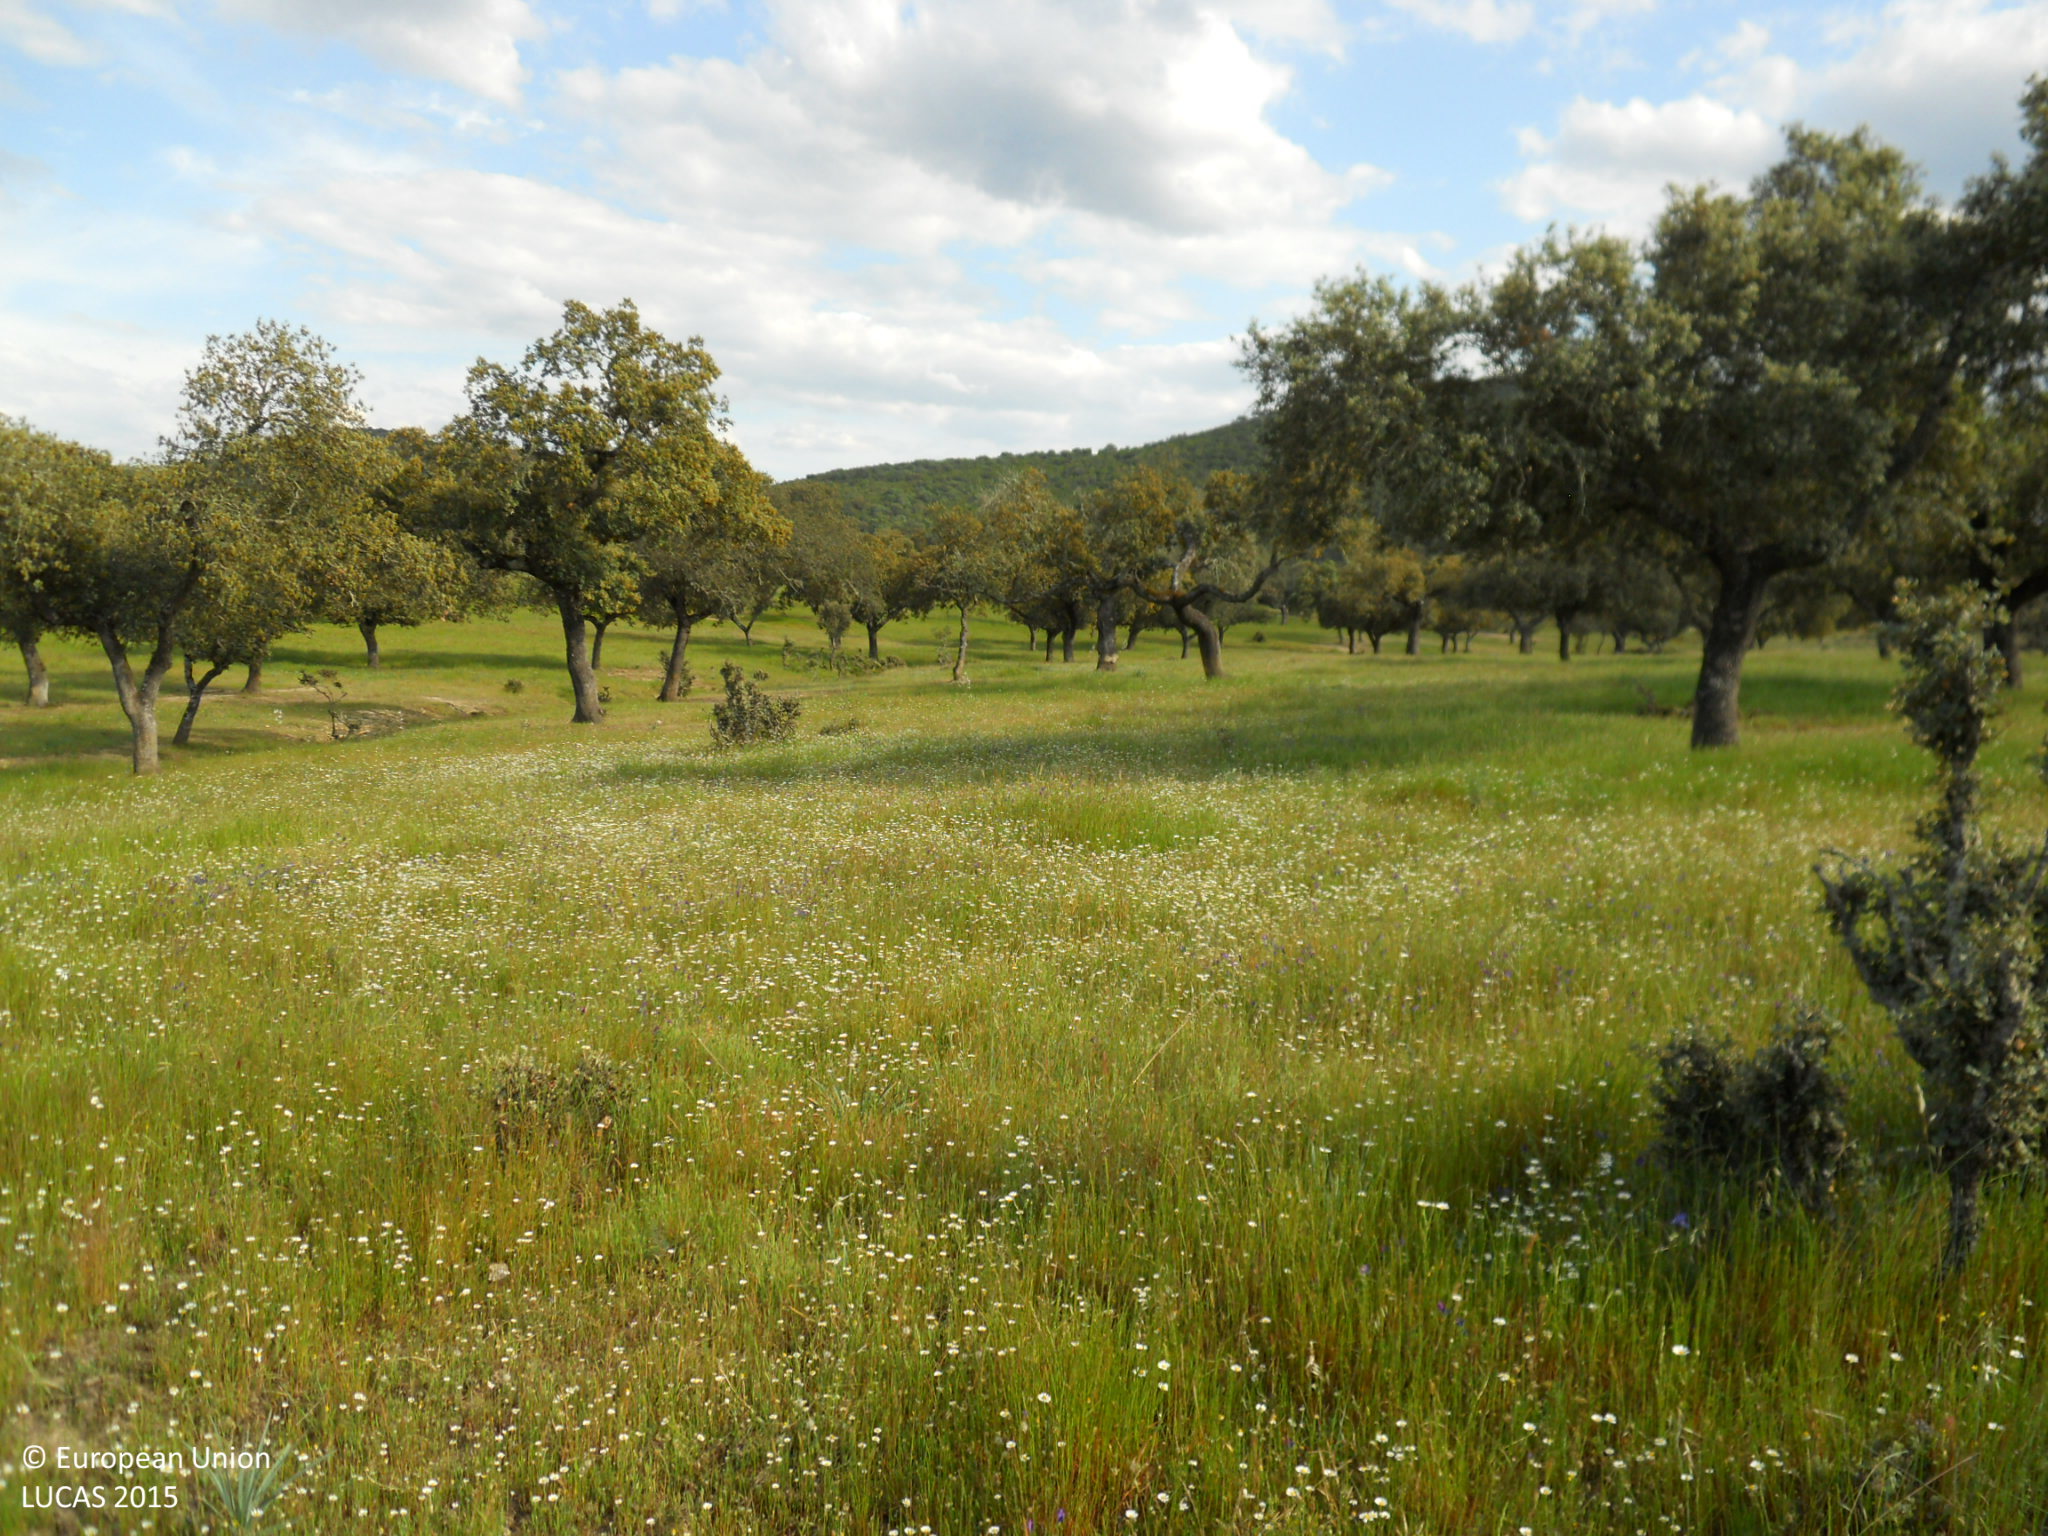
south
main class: Woodland
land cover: Broadleaved woodland
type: broadleaved evergreen forest
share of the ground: 10 - 25 %
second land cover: Grassland without tree/shrub cover
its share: > 75 %
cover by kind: herbaceous plants 65 %, broadleaved forest trees 35 %
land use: Forestry
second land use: Agriculture (excluding fallow land and kitchen gardens)
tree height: > 5 m
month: April
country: ES
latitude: 39.2857
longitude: -6.8030
